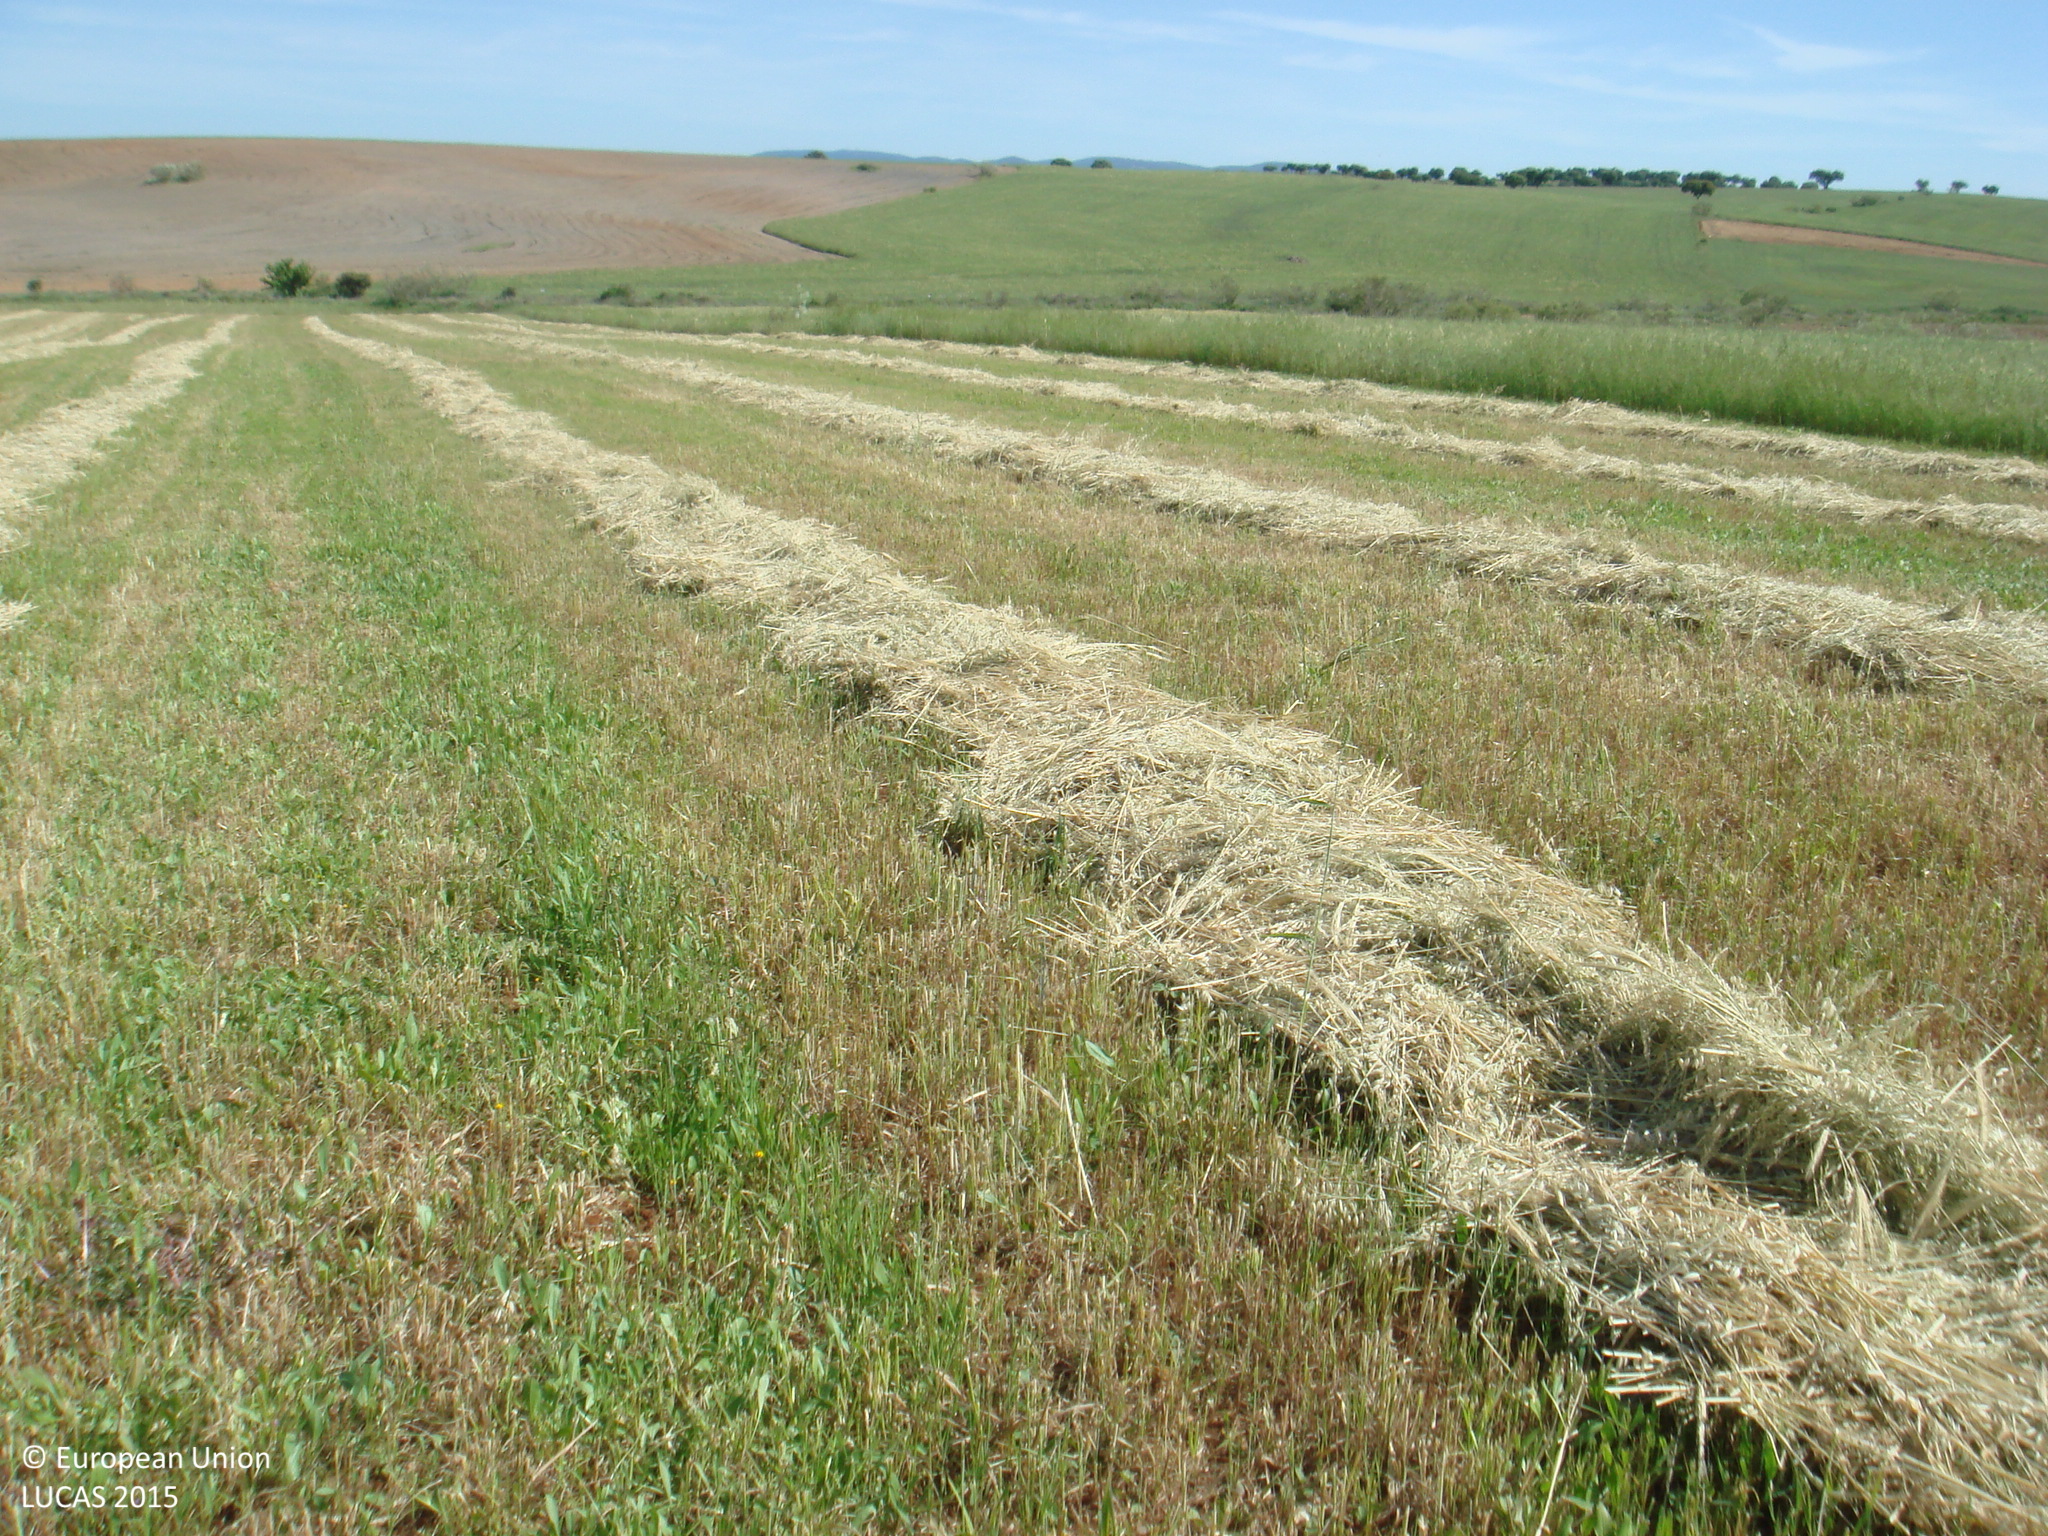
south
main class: Grassland
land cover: Grassland without tree/shrub cover
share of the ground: > 75 %
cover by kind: consolidated bare surface 80 %, herbaceous plants 20 %
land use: Agriculture (excluding fallow land and kitchen gardens)
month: April
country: ES
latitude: 38.4449
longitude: -5.1182
